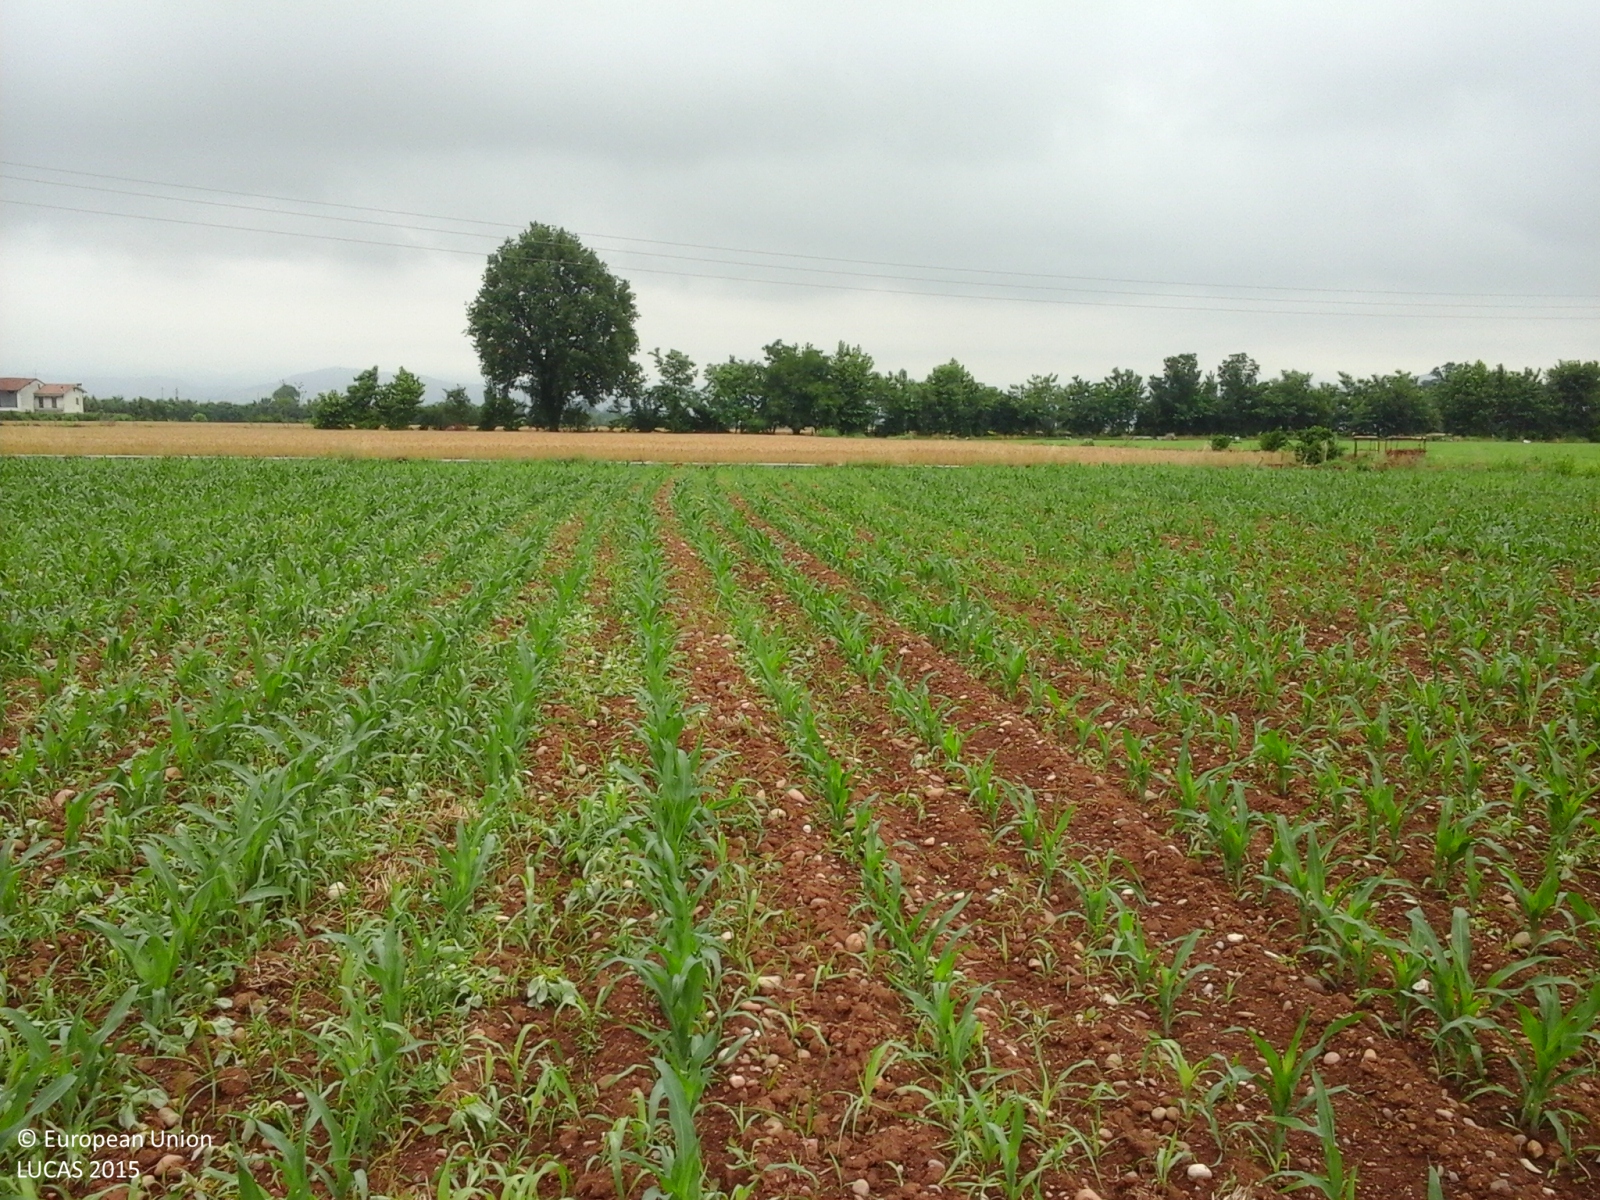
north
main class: Cropland
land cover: Maize
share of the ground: 10 - 25 %
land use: Agriculture (excluding fallow land and kitchen gardens)
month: June
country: IT
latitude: 45.5584
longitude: 9.9105
